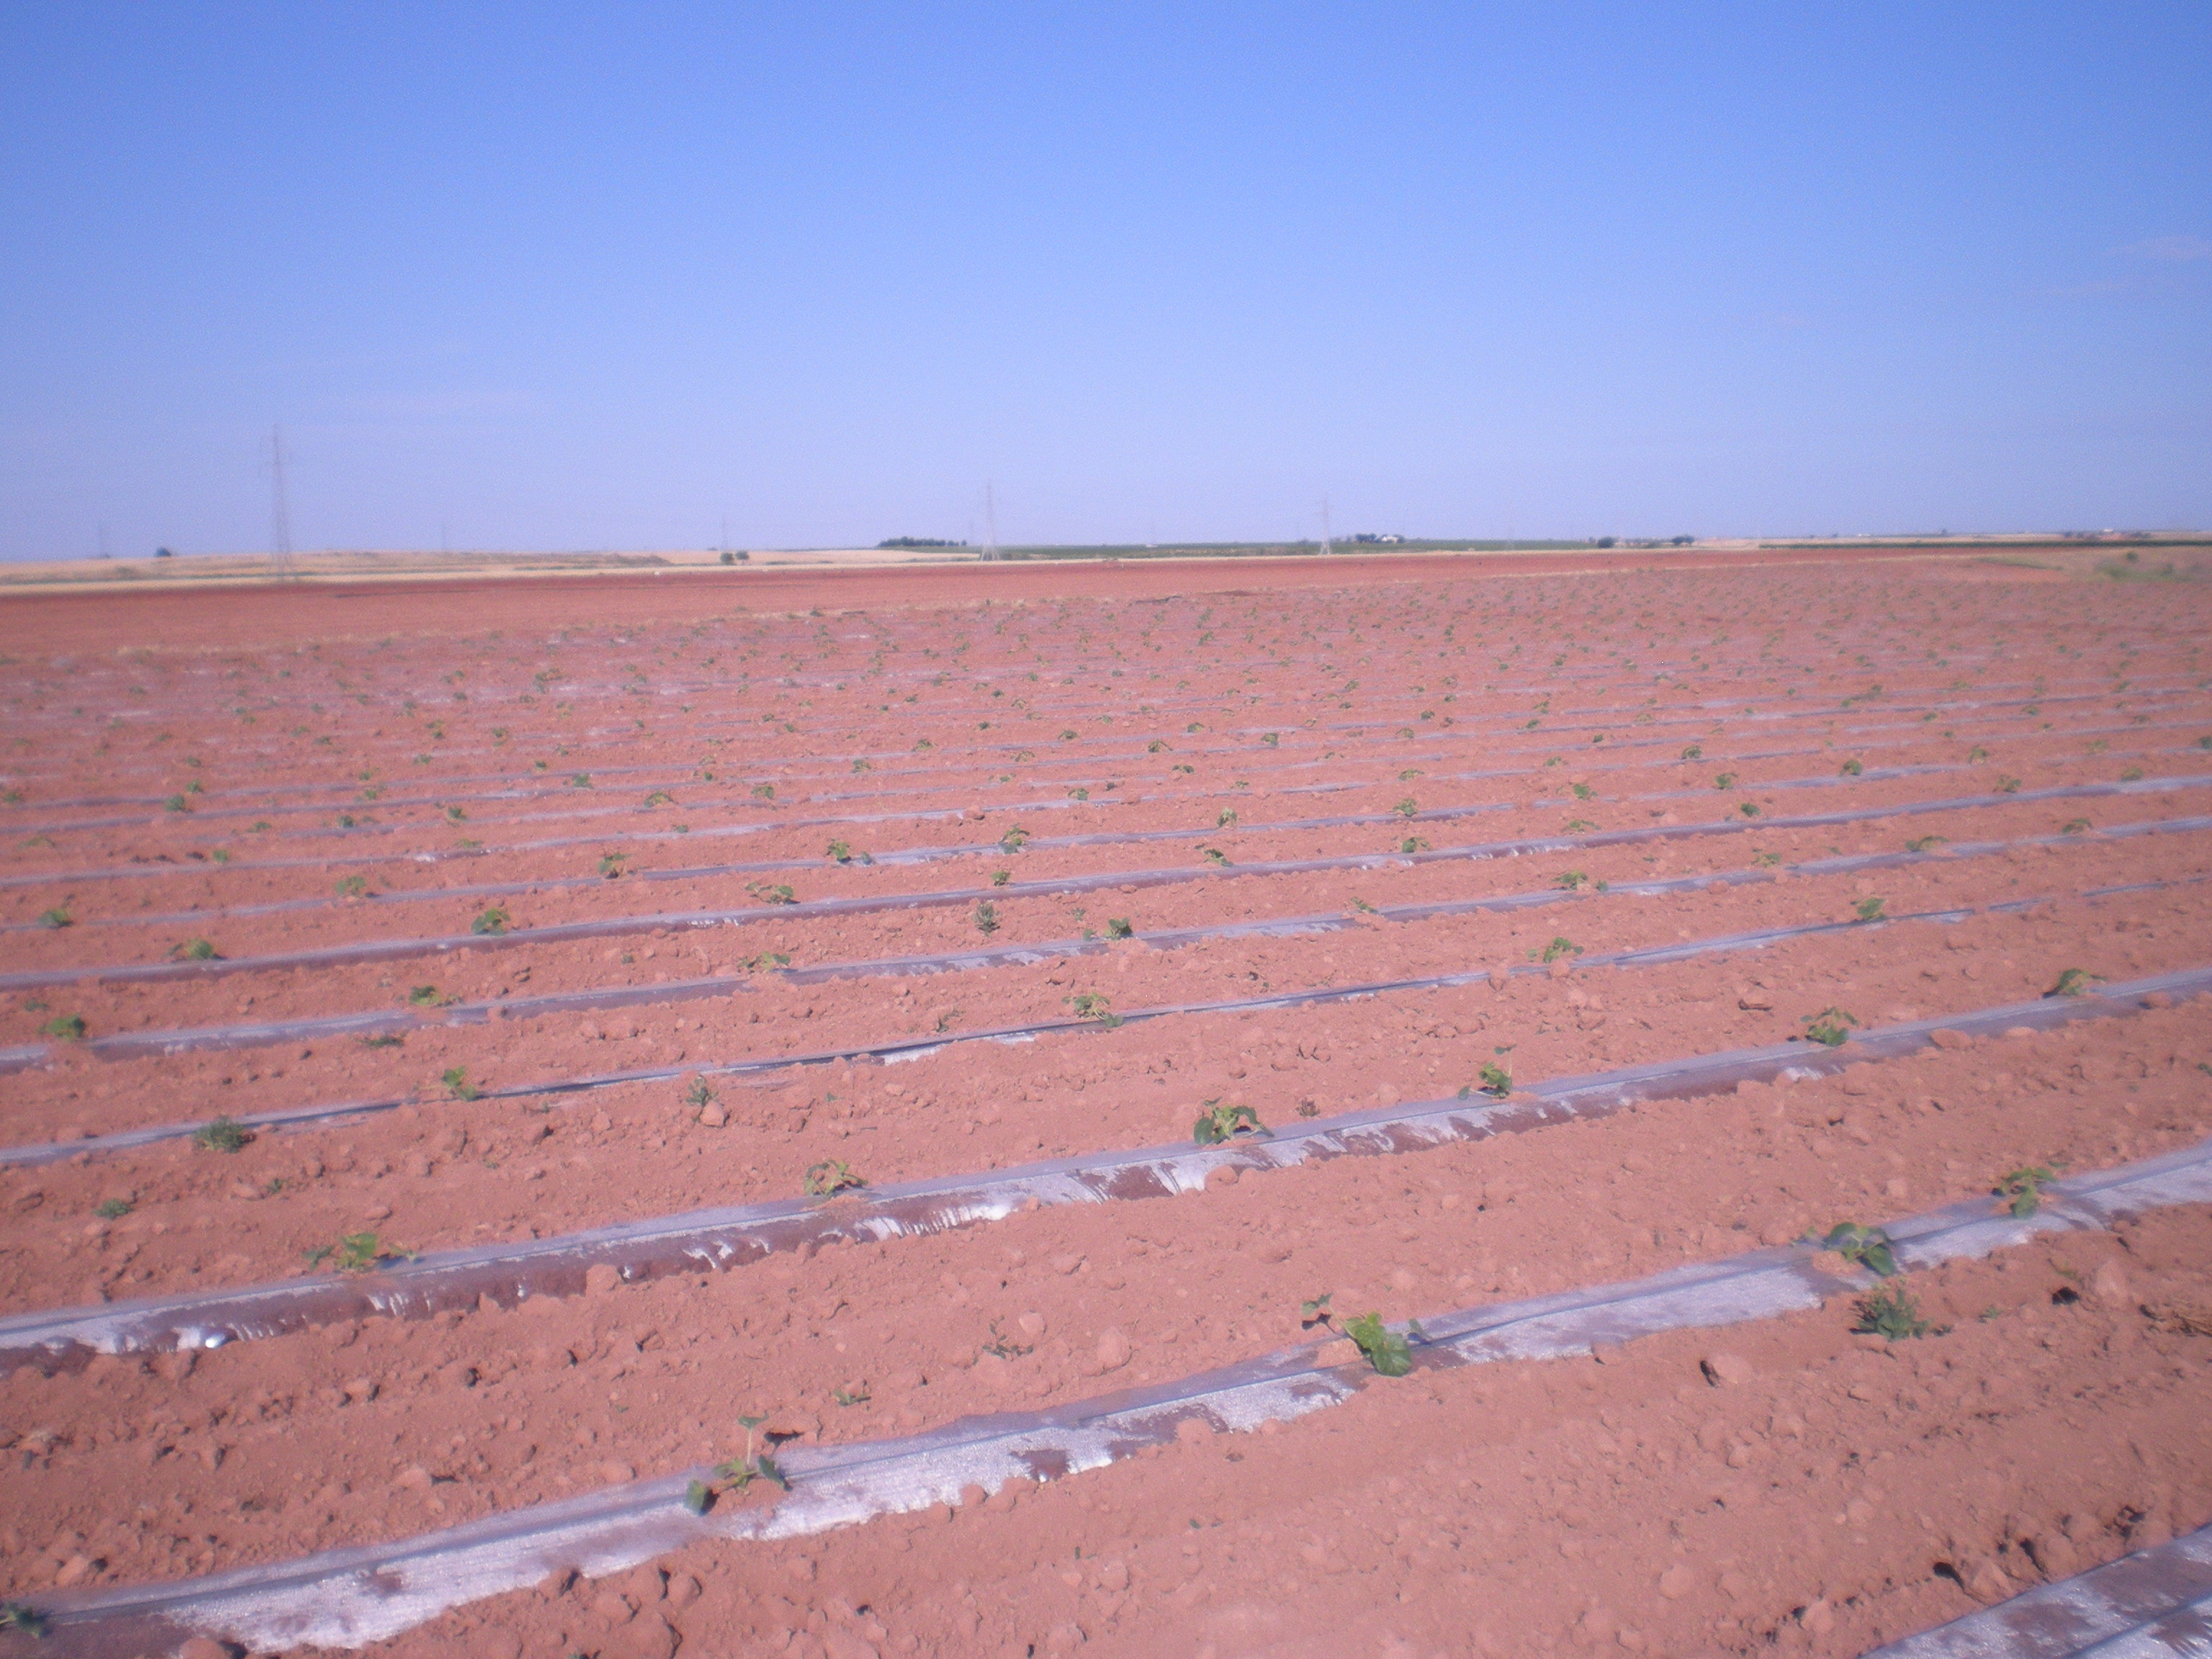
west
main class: Cropland
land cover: Other fresh vegetables
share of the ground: < 10 %
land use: Agriculture (excluding fallow land and kitchen gardens)
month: May
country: ES
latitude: 39.0398
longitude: -3.4754
